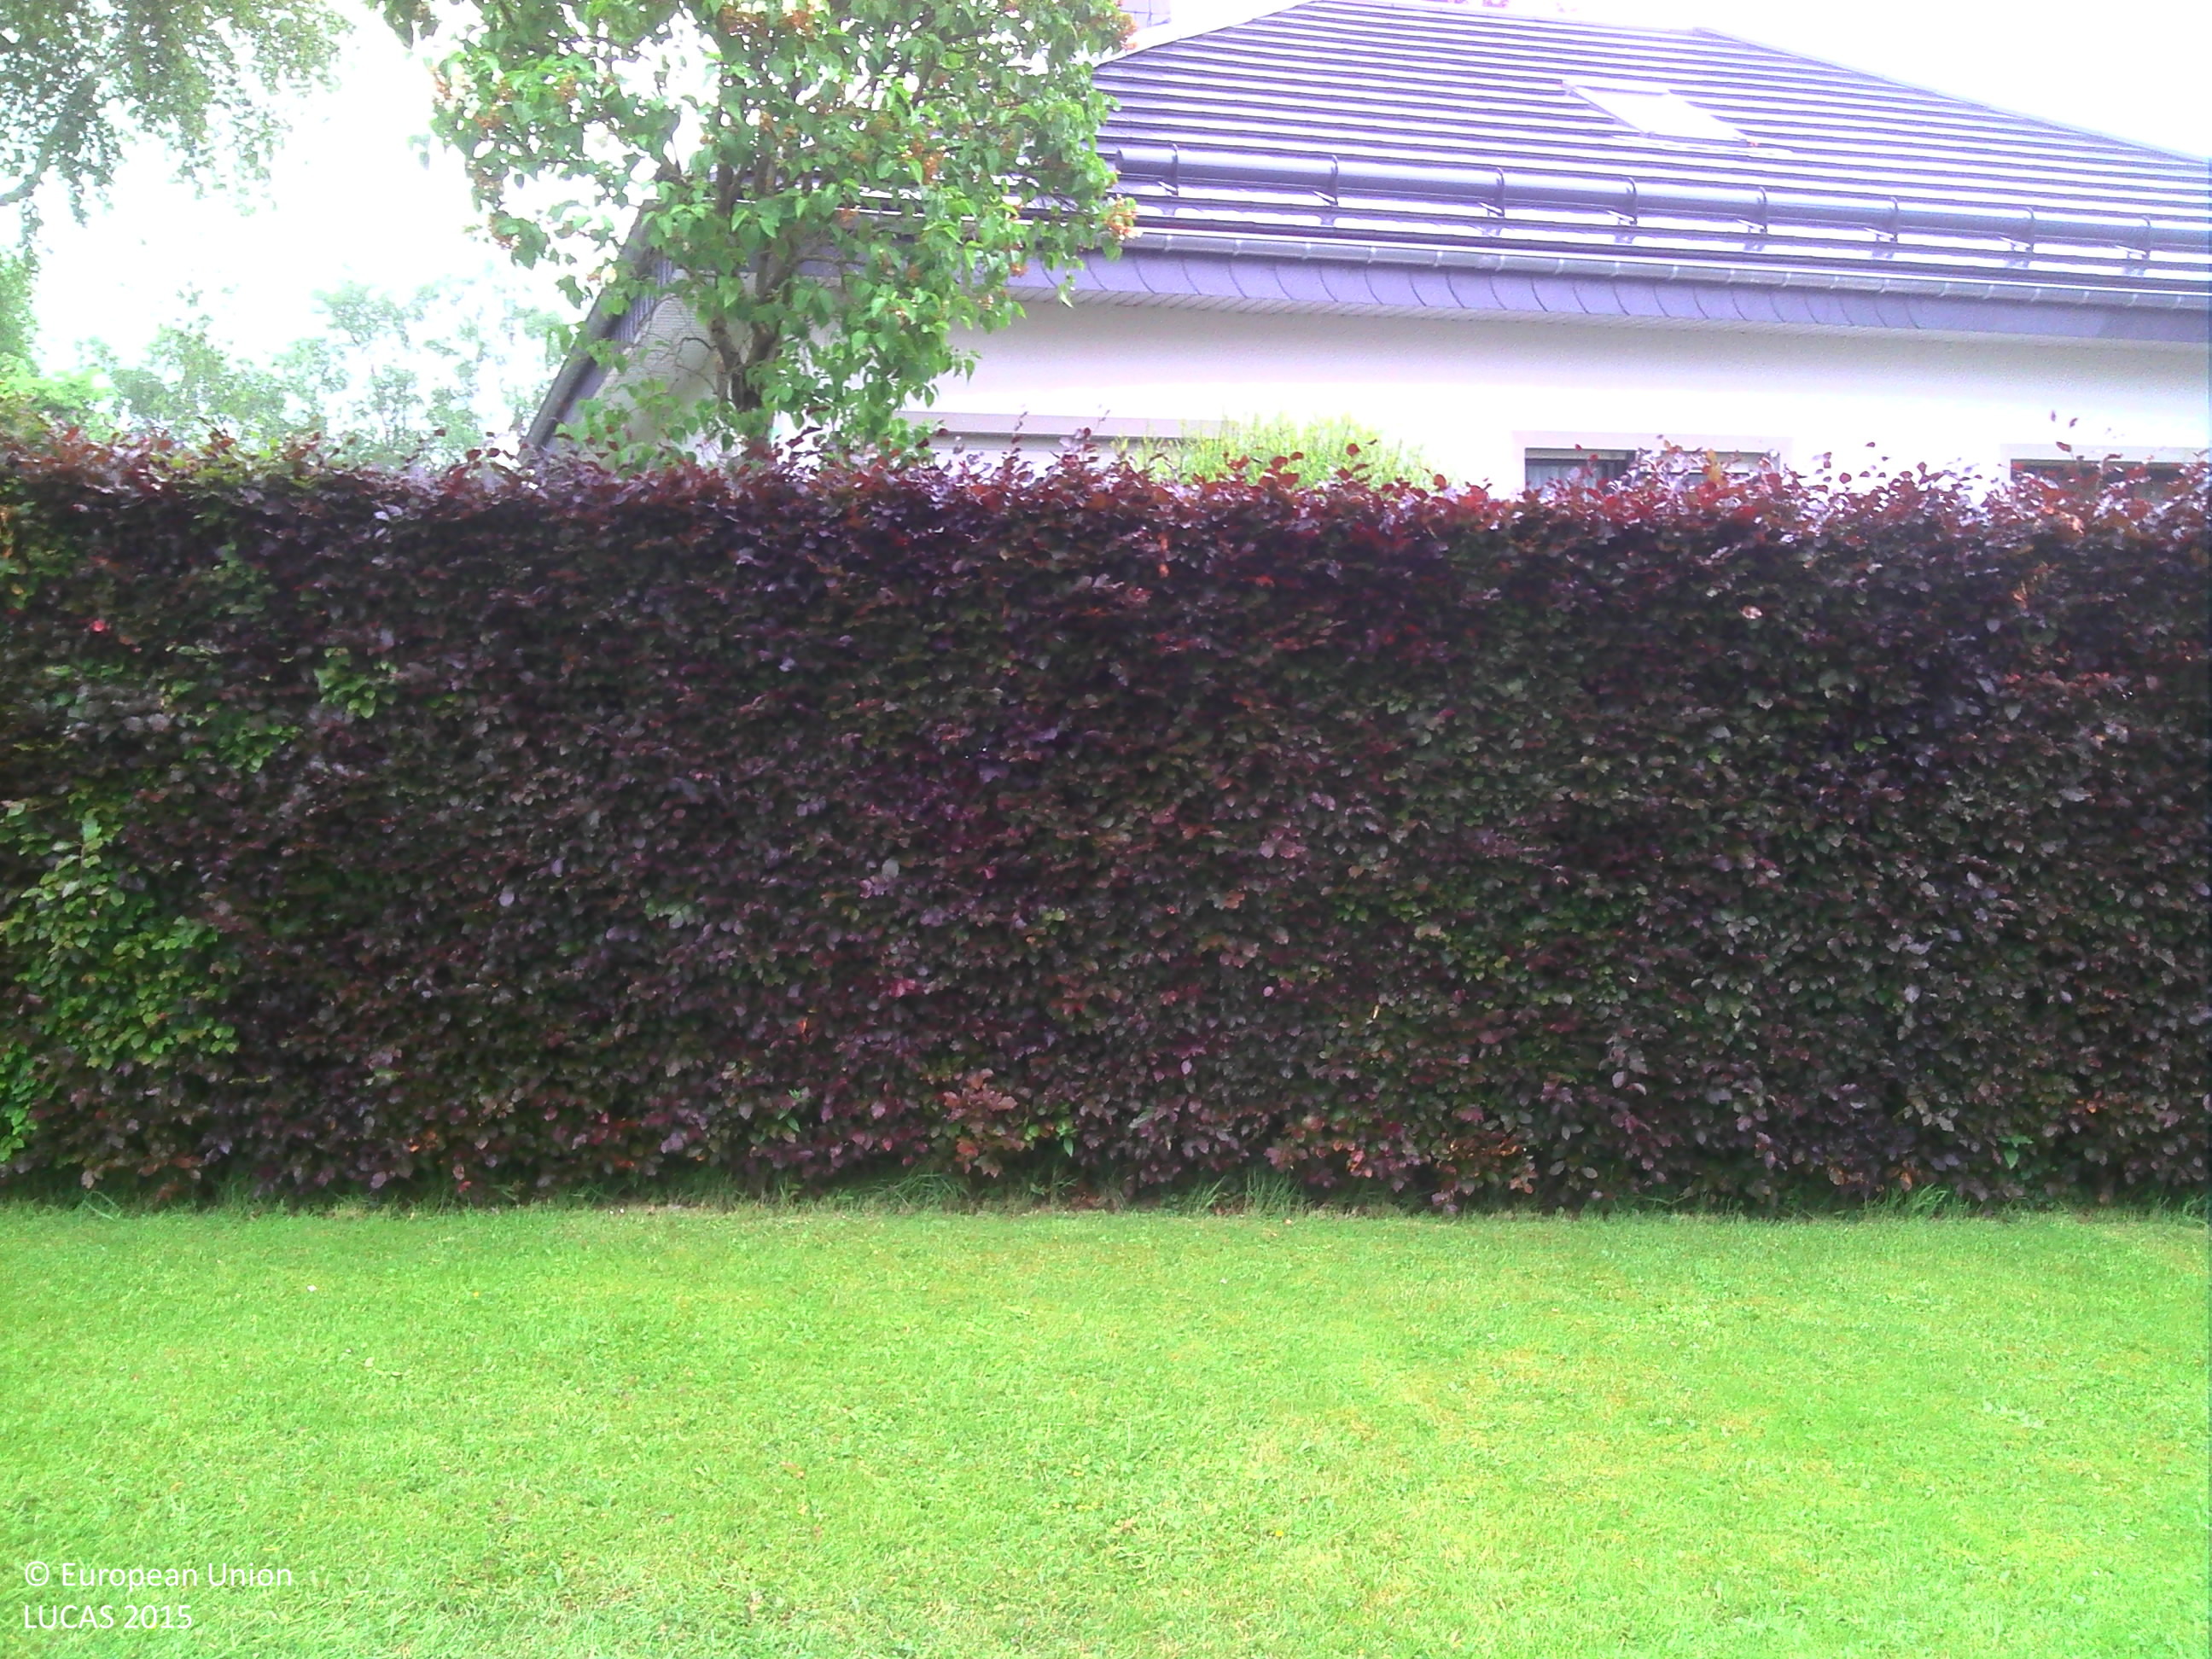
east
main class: Grassland
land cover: Grassland without tree/shrub cover
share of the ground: > 75 %
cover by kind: herbaceous plants 100 %
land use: Residential
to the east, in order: Grassland without tree/shrub cover; Artificial constructions in urban areas; Grassland without tree/shrub cover; Artificial constructions in urban areas
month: June
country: BE
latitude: 50.4301
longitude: 6.2970
